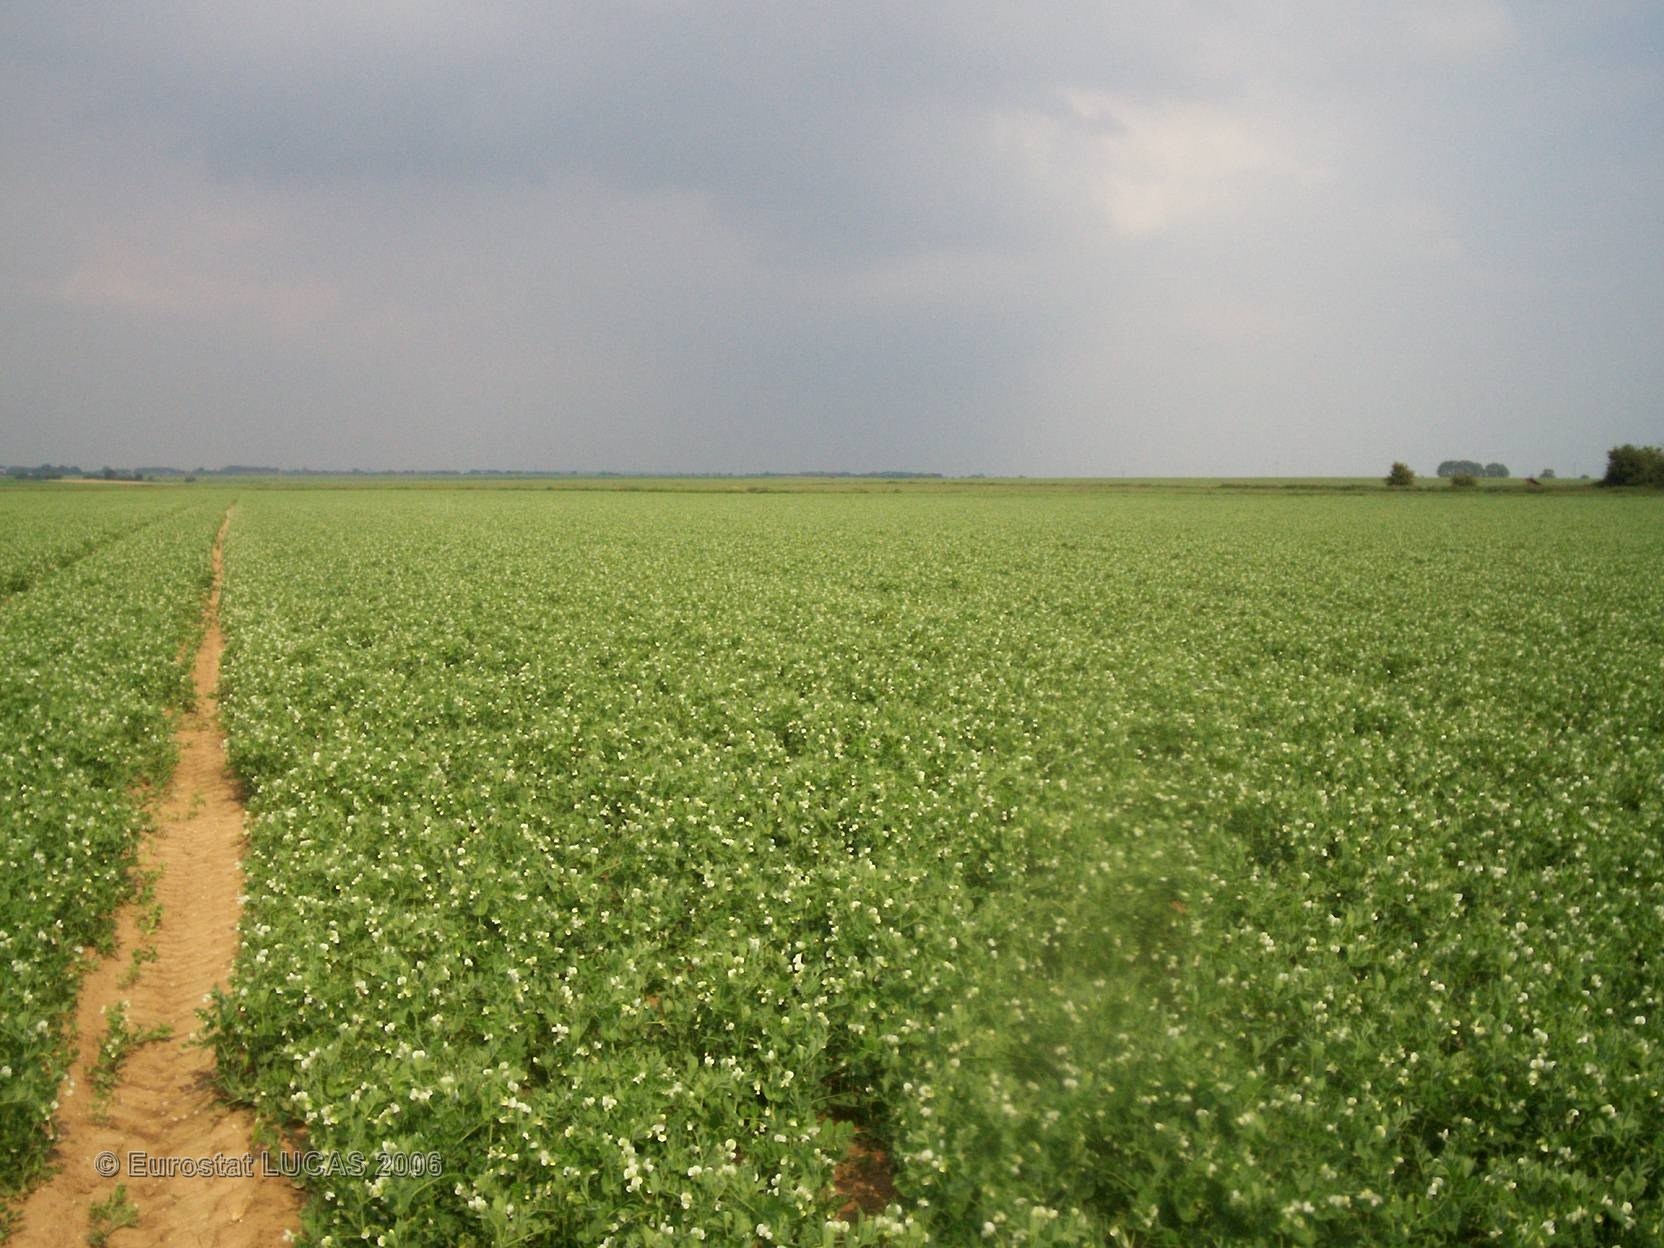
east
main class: Cropland
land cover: Other fresh vegetables
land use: Agriculture (excluding fallow land and kitchen gardens)
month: June
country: FR
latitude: 49.6801
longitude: 2.7130
